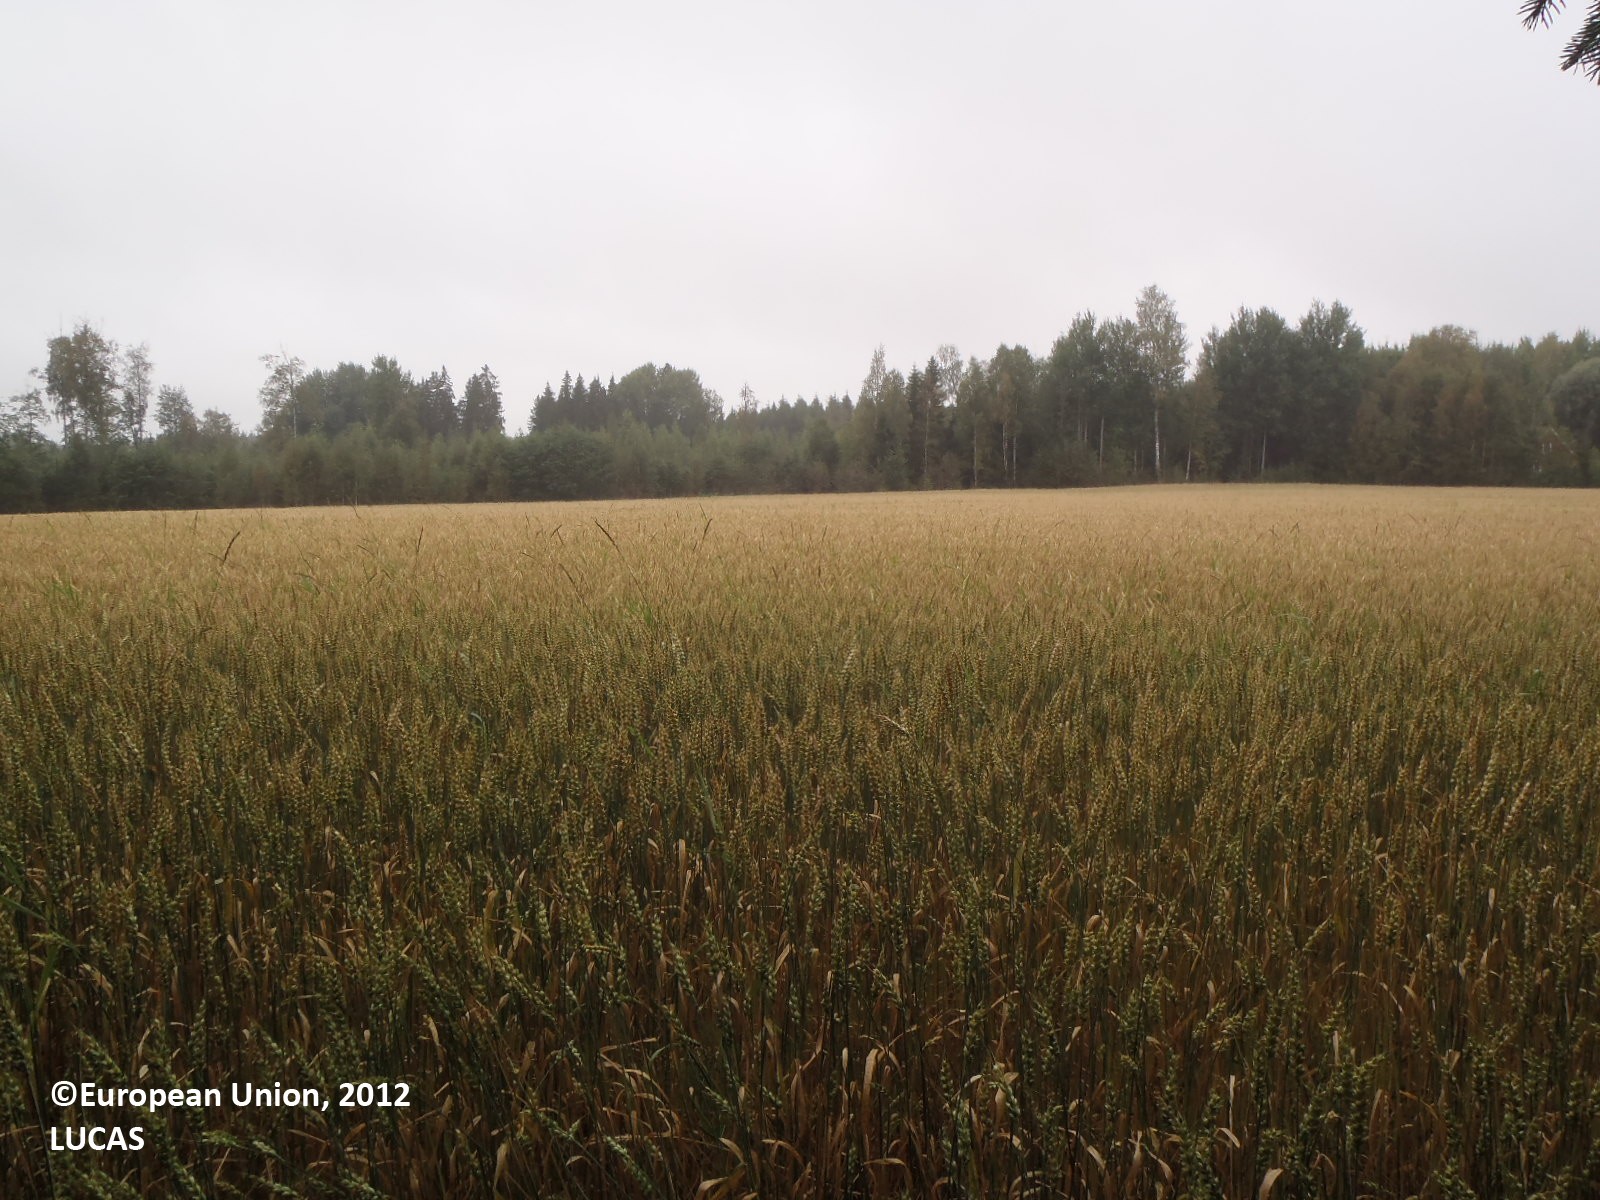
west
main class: Woodland
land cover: Spruce dominated mixed woodland
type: boreal forest
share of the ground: > 75 %
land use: Forestry
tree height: > 5 m
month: August
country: FI
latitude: 60.6886
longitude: 22.2056
